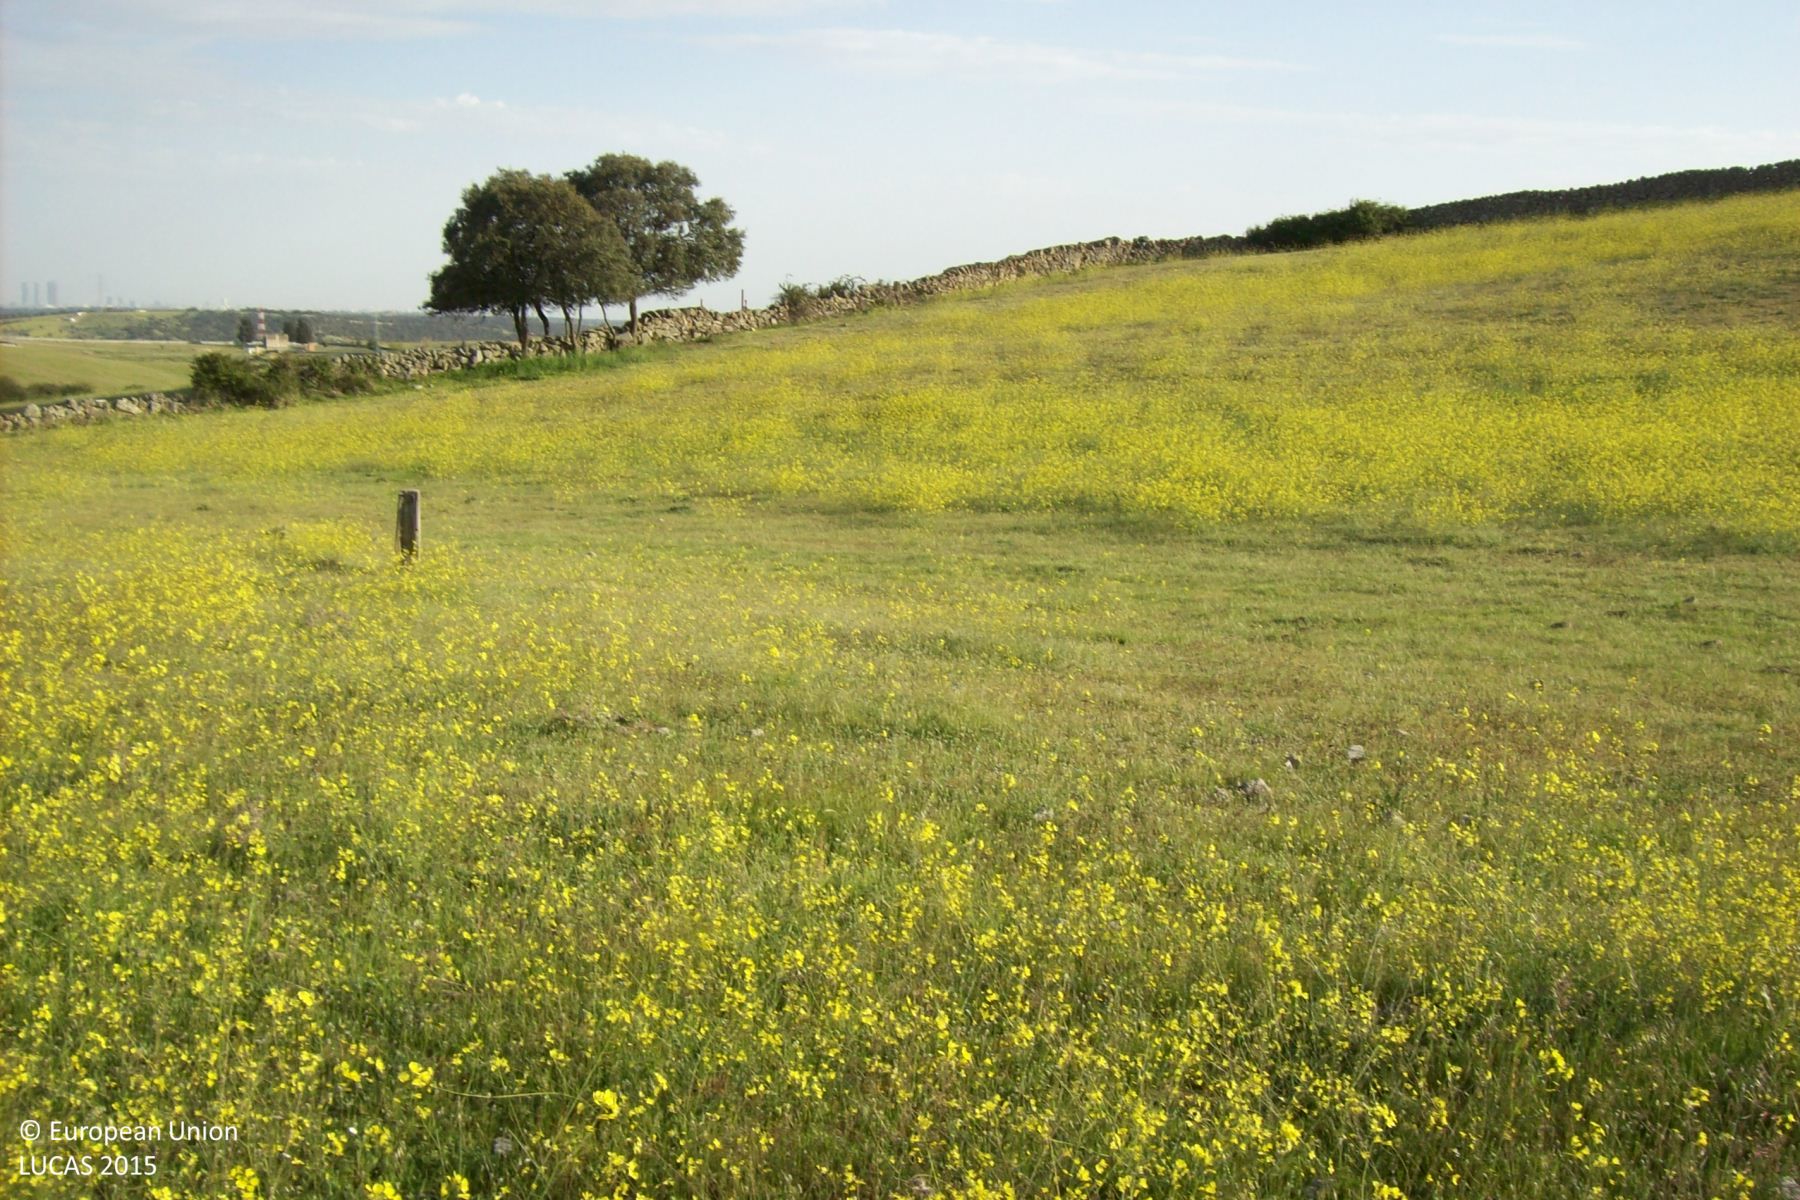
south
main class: Grassland
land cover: Grassland without tree/shrub cover
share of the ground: > 75 %
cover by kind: herbaceous plants 100 %
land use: Agriculture (excluding fallow land and kitchen gardens)
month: April
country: ES
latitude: 40.6257
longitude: -3.7902
